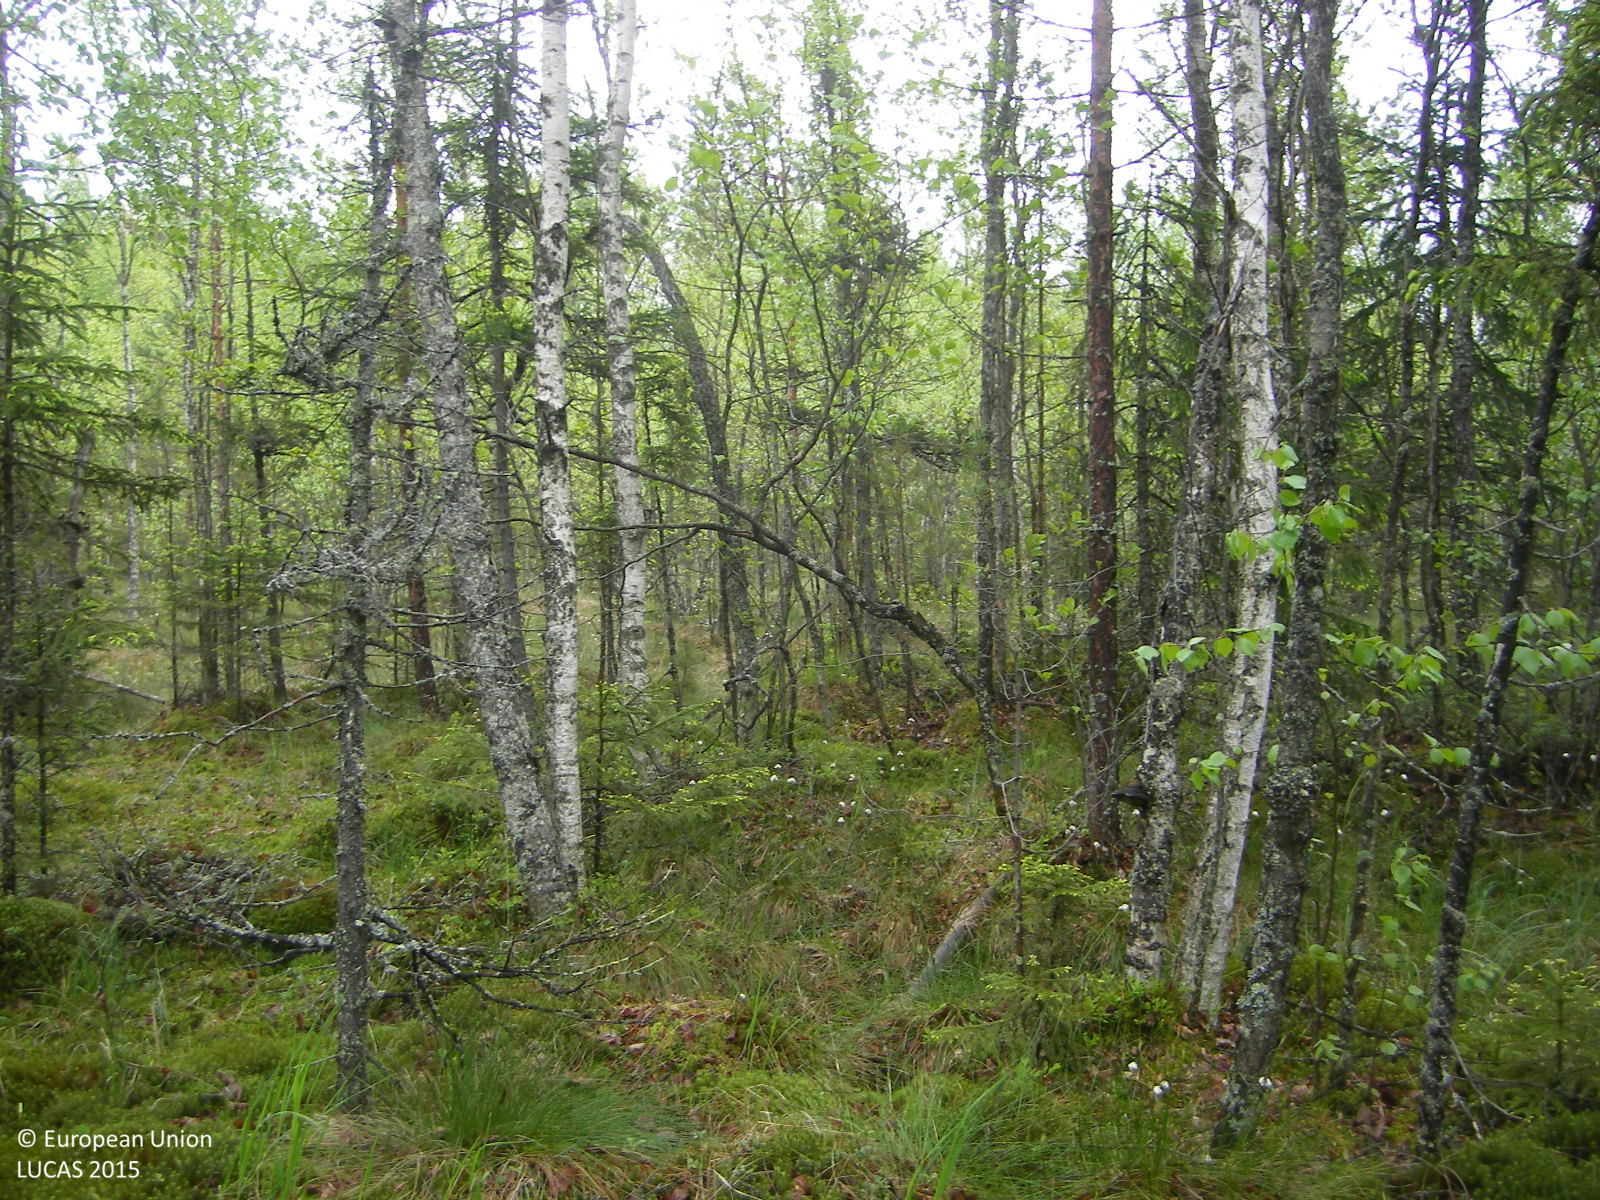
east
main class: Woodland
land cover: Broadleaved woodland
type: mire and swamp forests
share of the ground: 50 - 75 %
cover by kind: broadleaved forest trees 60 %, lichens and mosses 25 %, coniferous forest trees 10 %, herbaceous plants 5 %
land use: Semi-natural and natural areas not in use
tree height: > 5 m
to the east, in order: Broadleaved woodland; Electric lines; Paved roads, cycling and walking lanes; Ditches and canals; Spruce dominated mixed woodland; Broadleaved woodland; Abandoned hedges; Broadleaved woodland
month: June
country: FI
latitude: 60.3163
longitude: 24.7588
